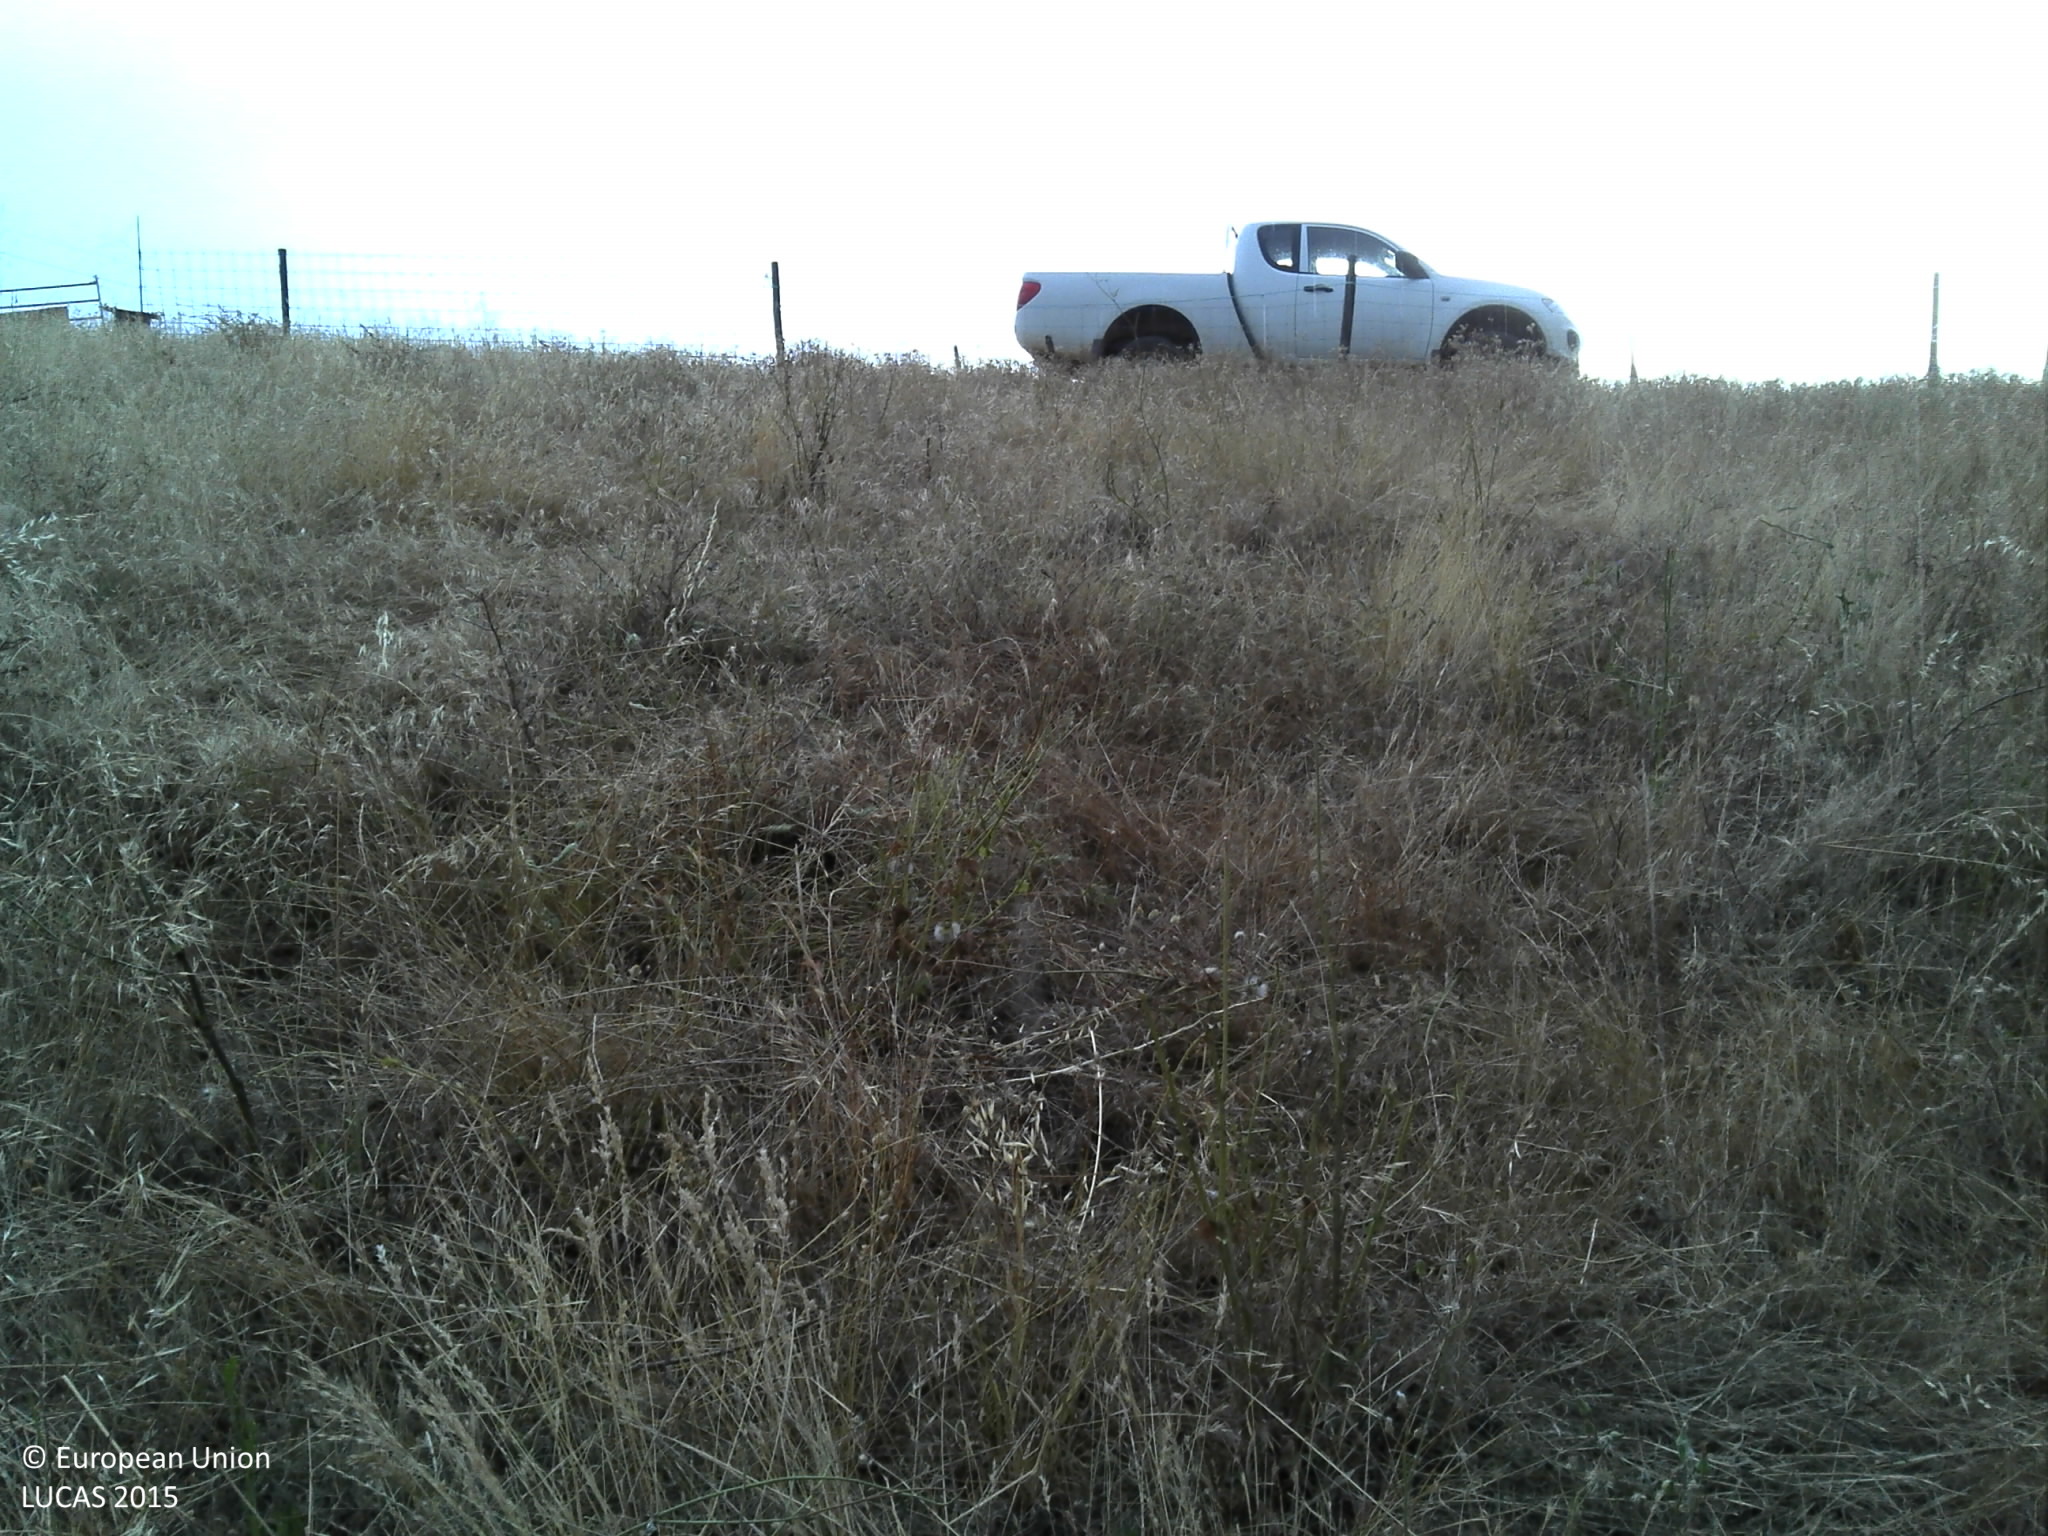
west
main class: Grassland
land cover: Grassland without tree/shrub cover
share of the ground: > 75 %
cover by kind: herbaceous plants 100 %
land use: Agriculture (excluding fallow land and kitchen gardens)
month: June
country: PT
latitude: 37.7476
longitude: -7.5497
